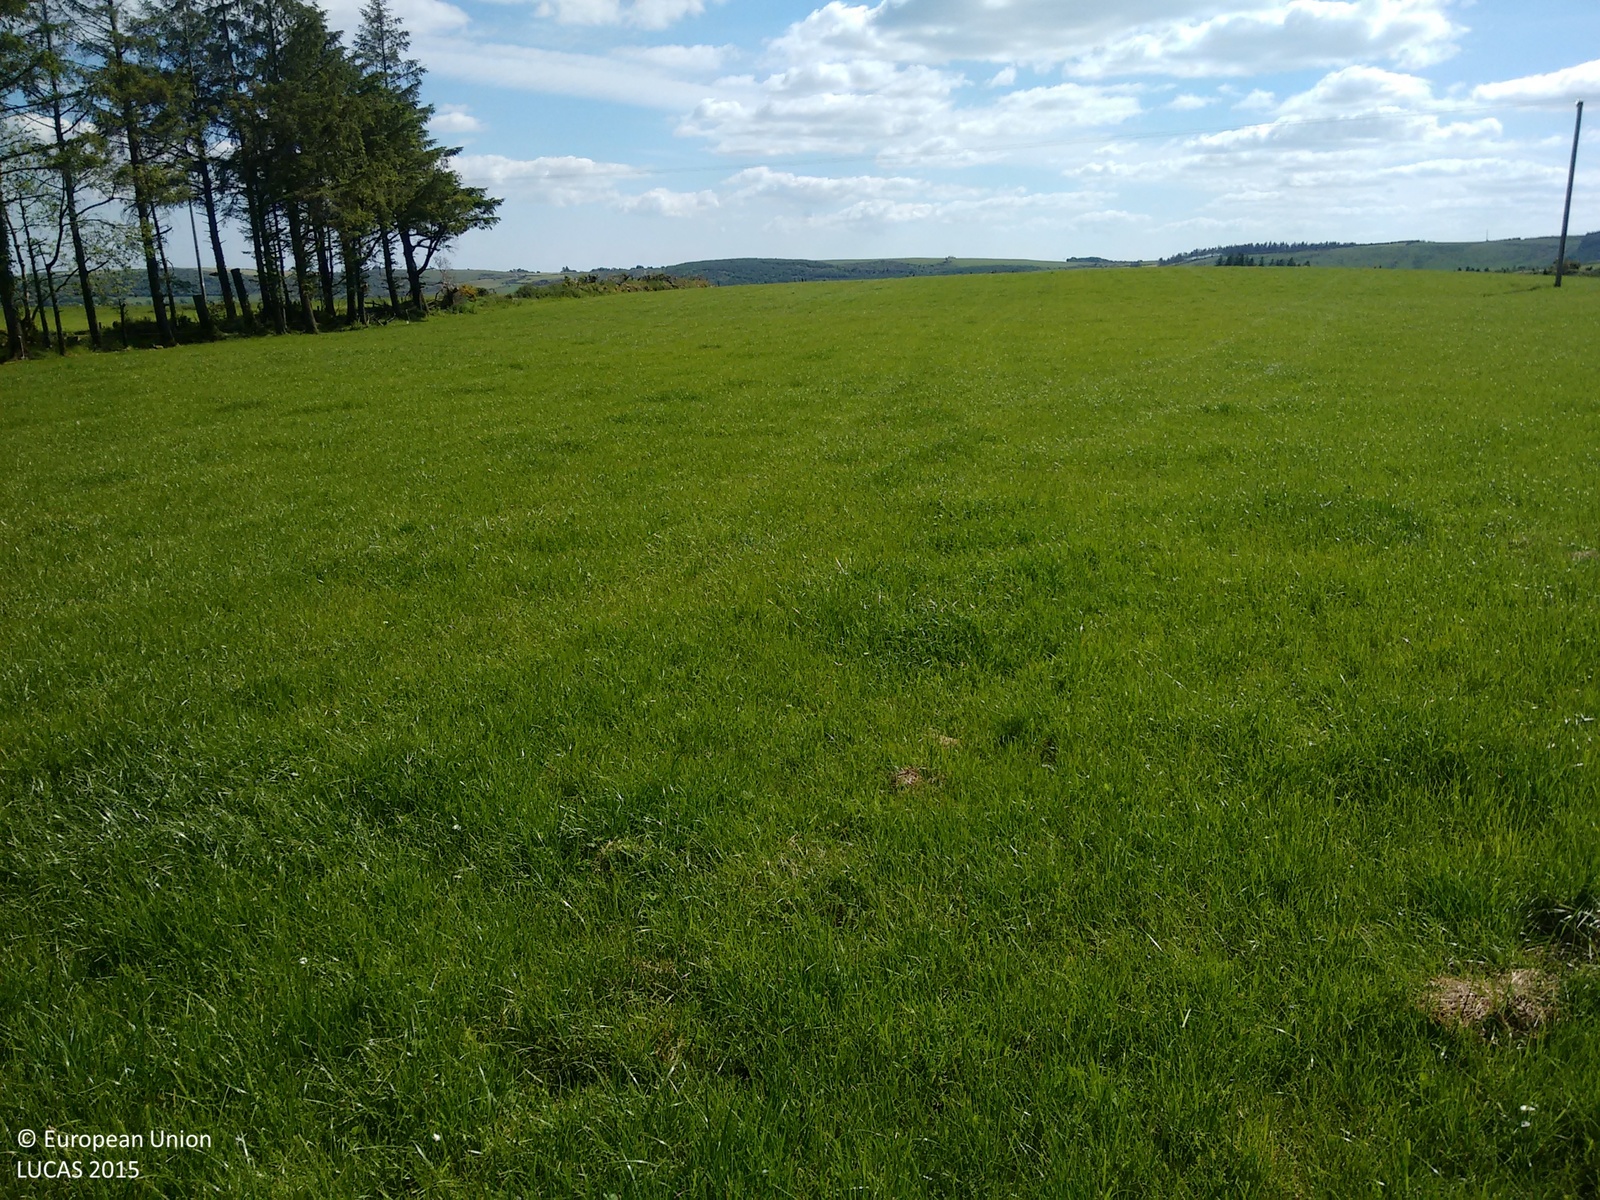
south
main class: Grassland
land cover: Grassland without tree/shrub cover
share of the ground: > 75 %
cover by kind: herbaceous plants 95 %, shrubs 5 %
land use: Agriculture (excluding fallow land and kitchen gardens)
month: June
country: IE
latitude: 51.9911
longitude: -8.8628
